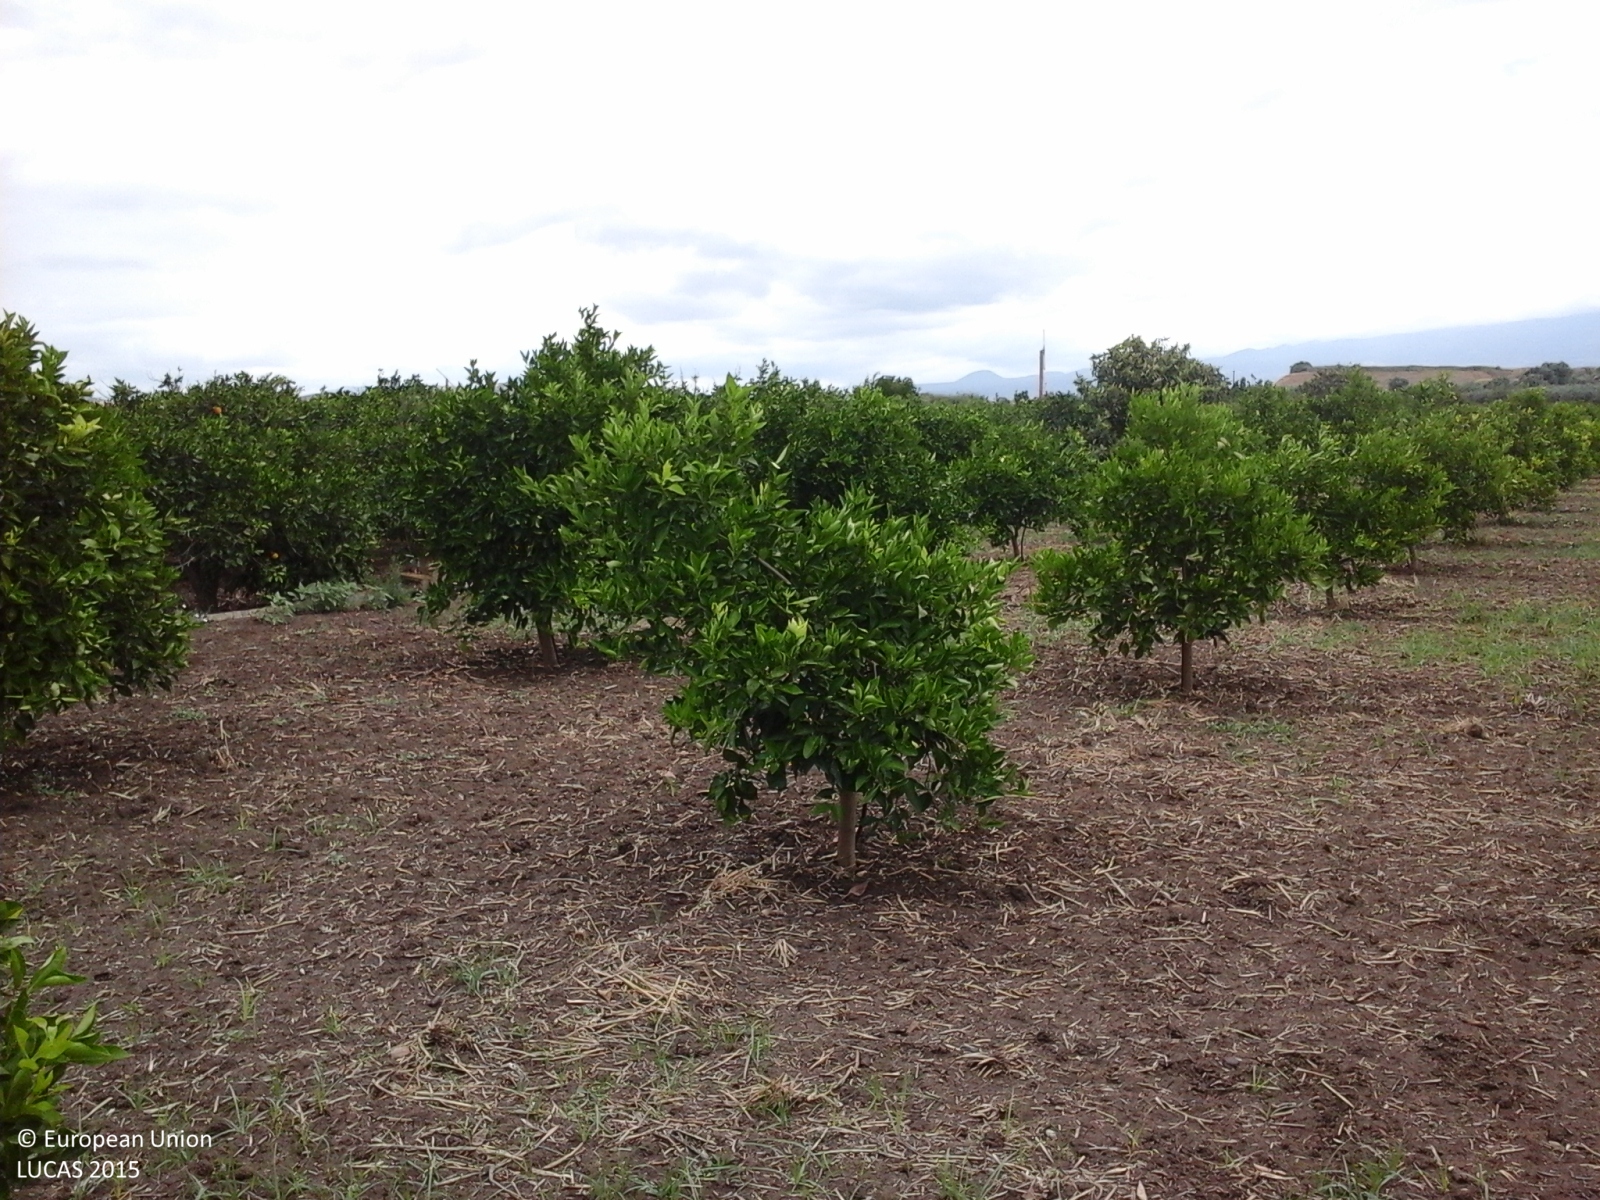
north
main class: Cropland
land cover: Oranges
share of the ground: > 75 %
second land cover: Spontaneously vegetated surfaces
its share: > 75 %
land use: Agriculture (excluding fallow land and kitchen gardens)
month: June
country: IT
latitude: 37.4970
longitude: 14.8399
